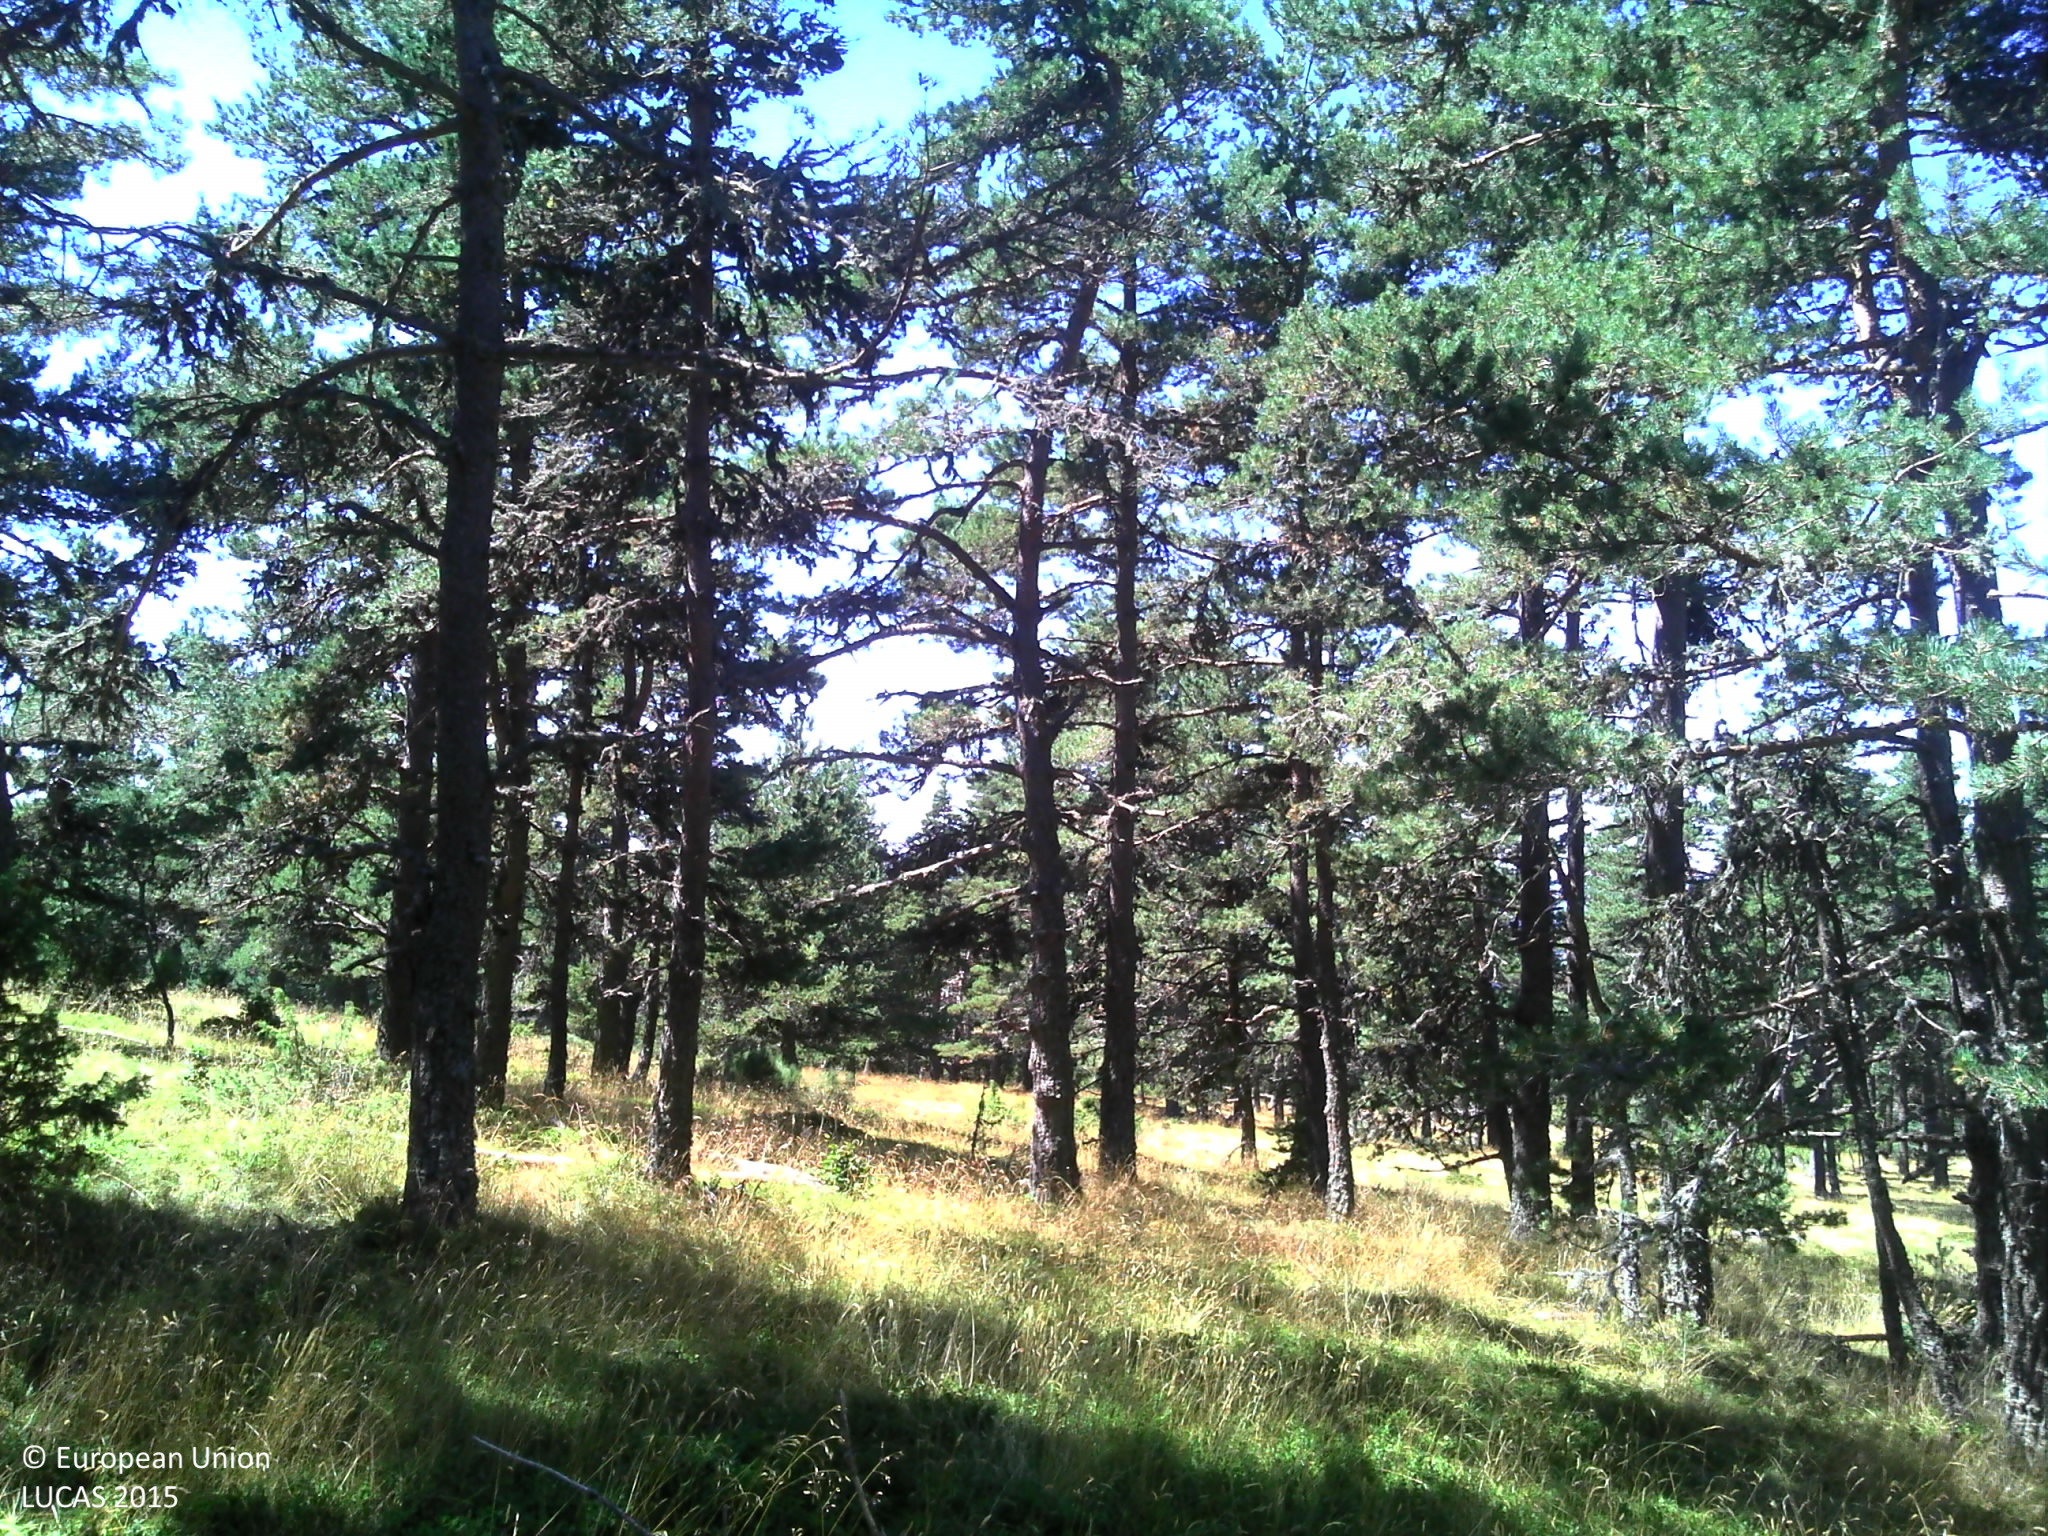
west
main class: Woodland
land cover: Pine dominated coniferous woodland
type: alpine coniferous forest
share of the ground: > 75 %
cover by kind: coniferous forest trees 95 %, broadleaved forest trees 5 %
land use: Agriculture (excluding fallow land and kitchen gardens)
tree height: > 5 m
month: August
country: FR
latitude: 44.6733
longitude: 3.5335
